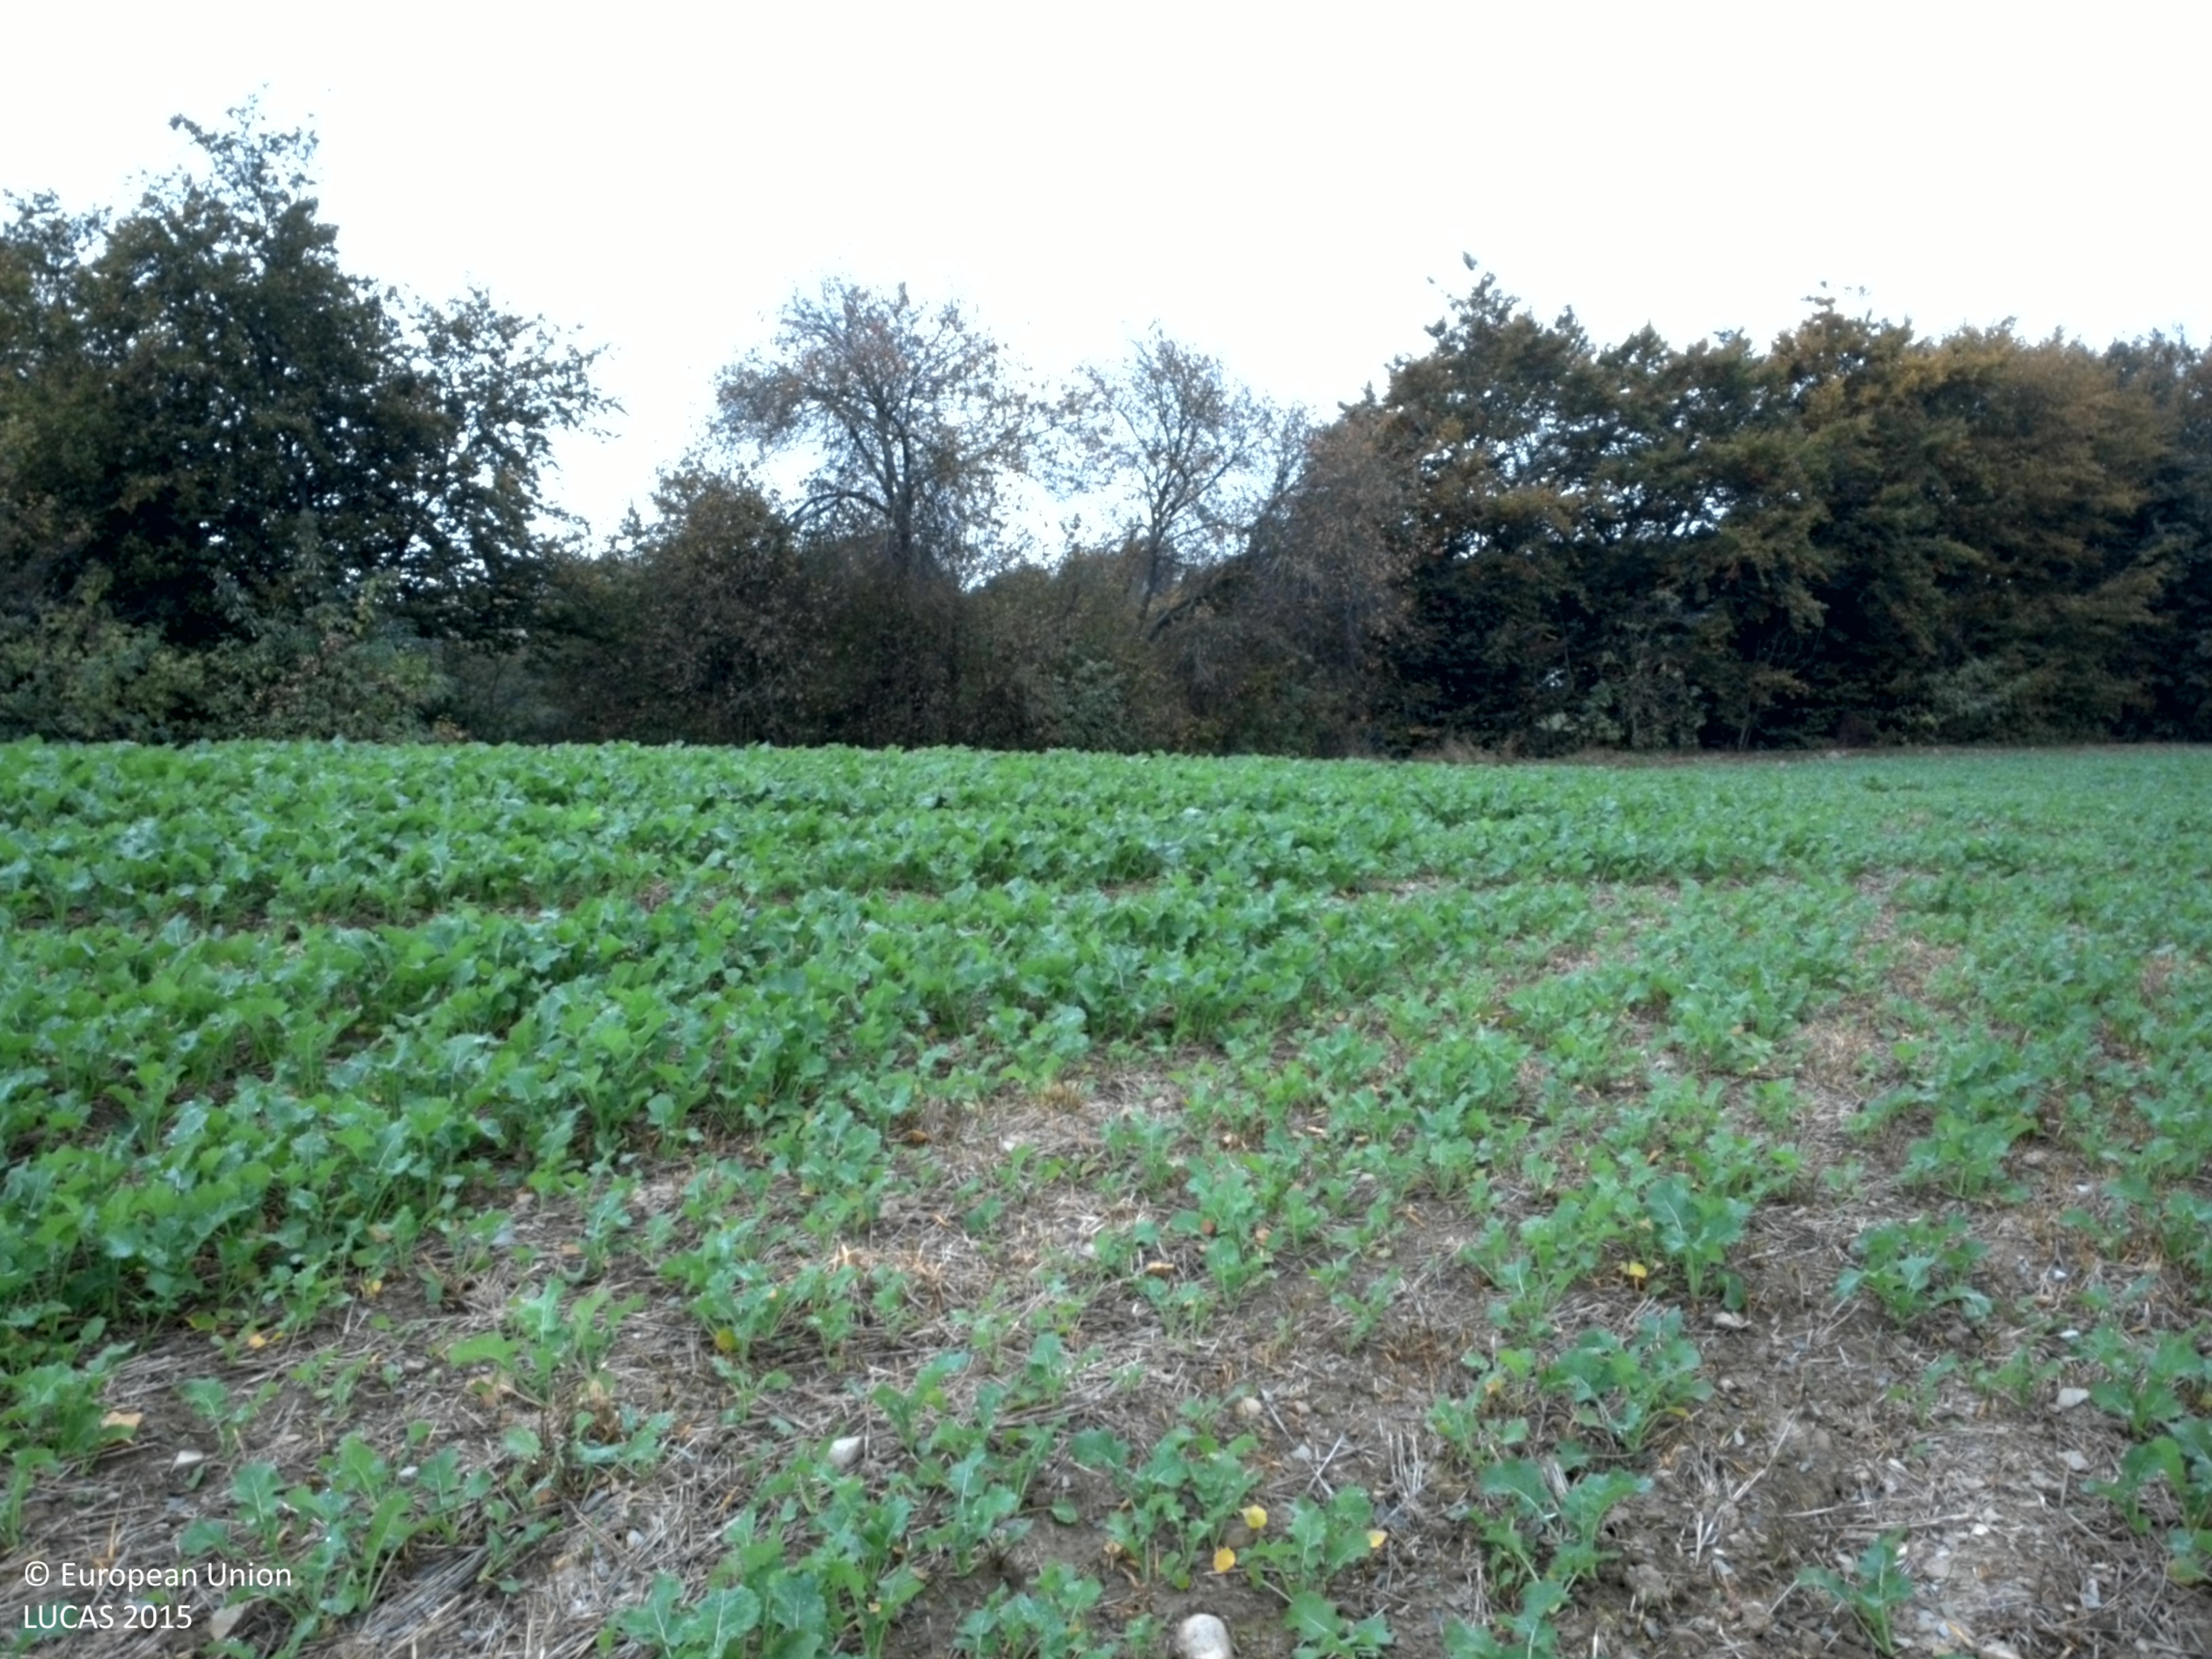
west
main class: Cropland
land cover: Rape and turnip rape
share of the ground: 50 - 75 %
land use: Agriculture (excluding fallow land and kitchen gardens)
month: October
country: SE
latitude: 55.6399
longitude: 13.9860
